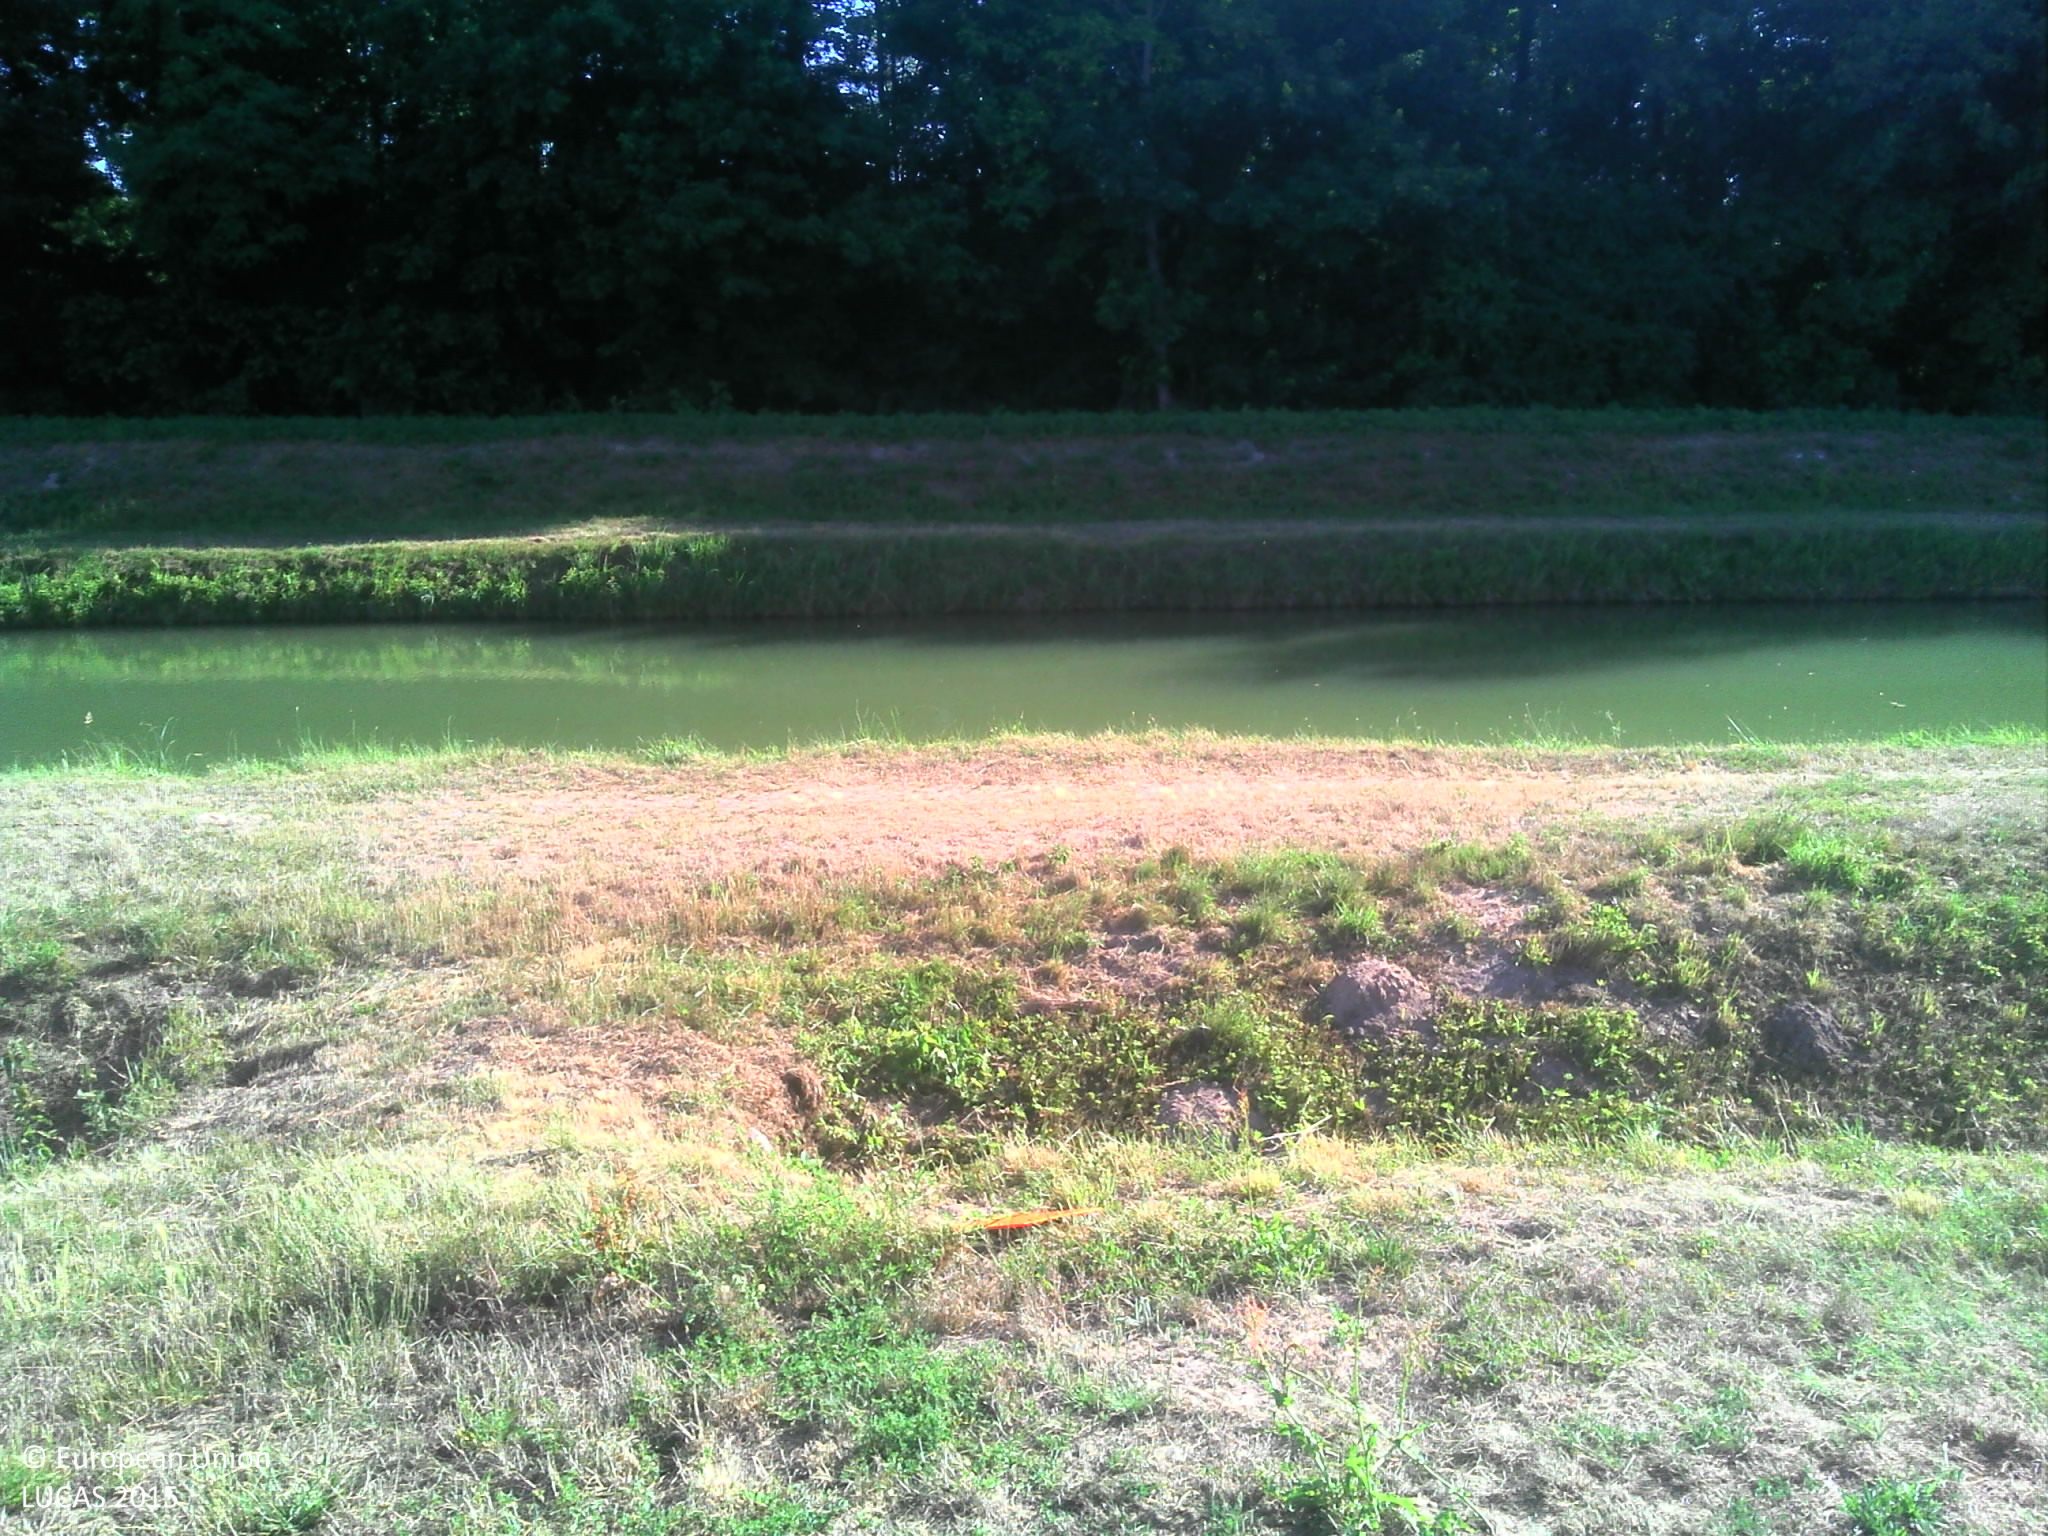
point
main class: Grassland
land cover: Grassland without tree/shrub cover
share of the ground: > 75 %
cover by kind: herbaceous plants 100 %
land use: Amenities, museums, leisure
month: June
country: FR
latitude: 47.2723
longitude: 1.4076
